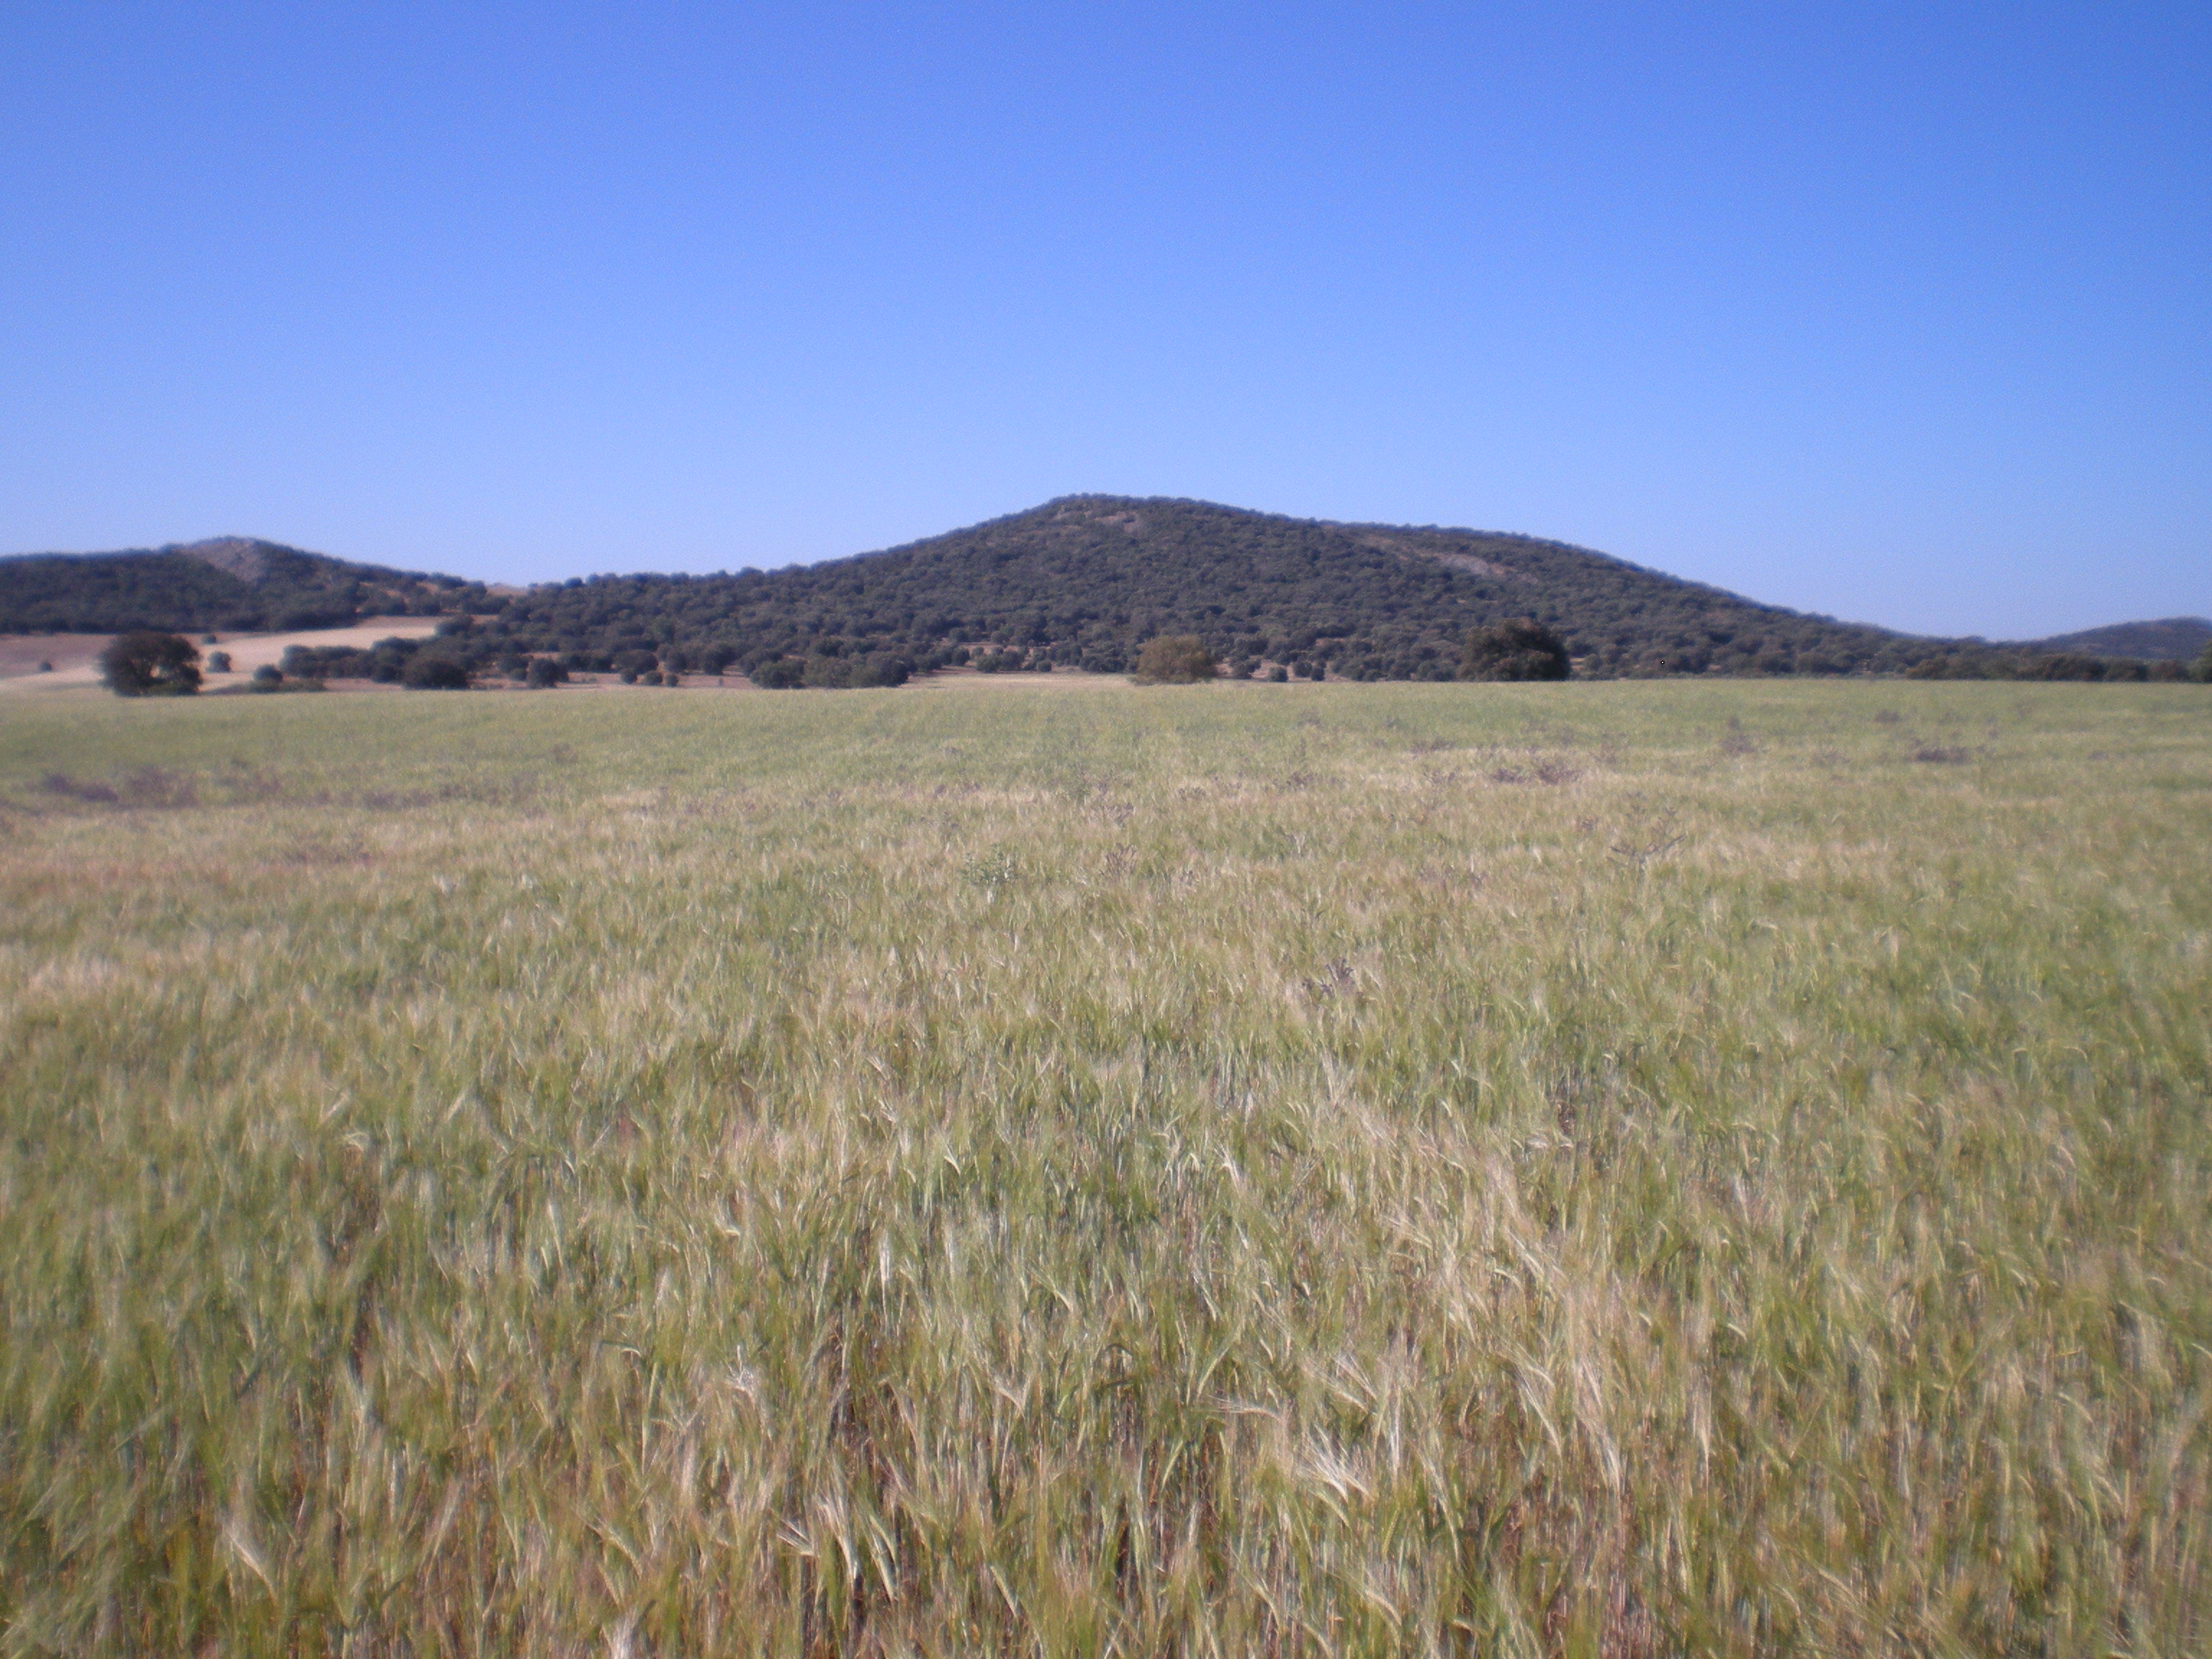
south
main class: Cropland
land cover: Barley
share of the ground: > 75 %
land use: Agriculture (excluding fallow land and kitchen gardens)
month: May
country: ES
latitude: 38.5724
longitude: -3.1481
